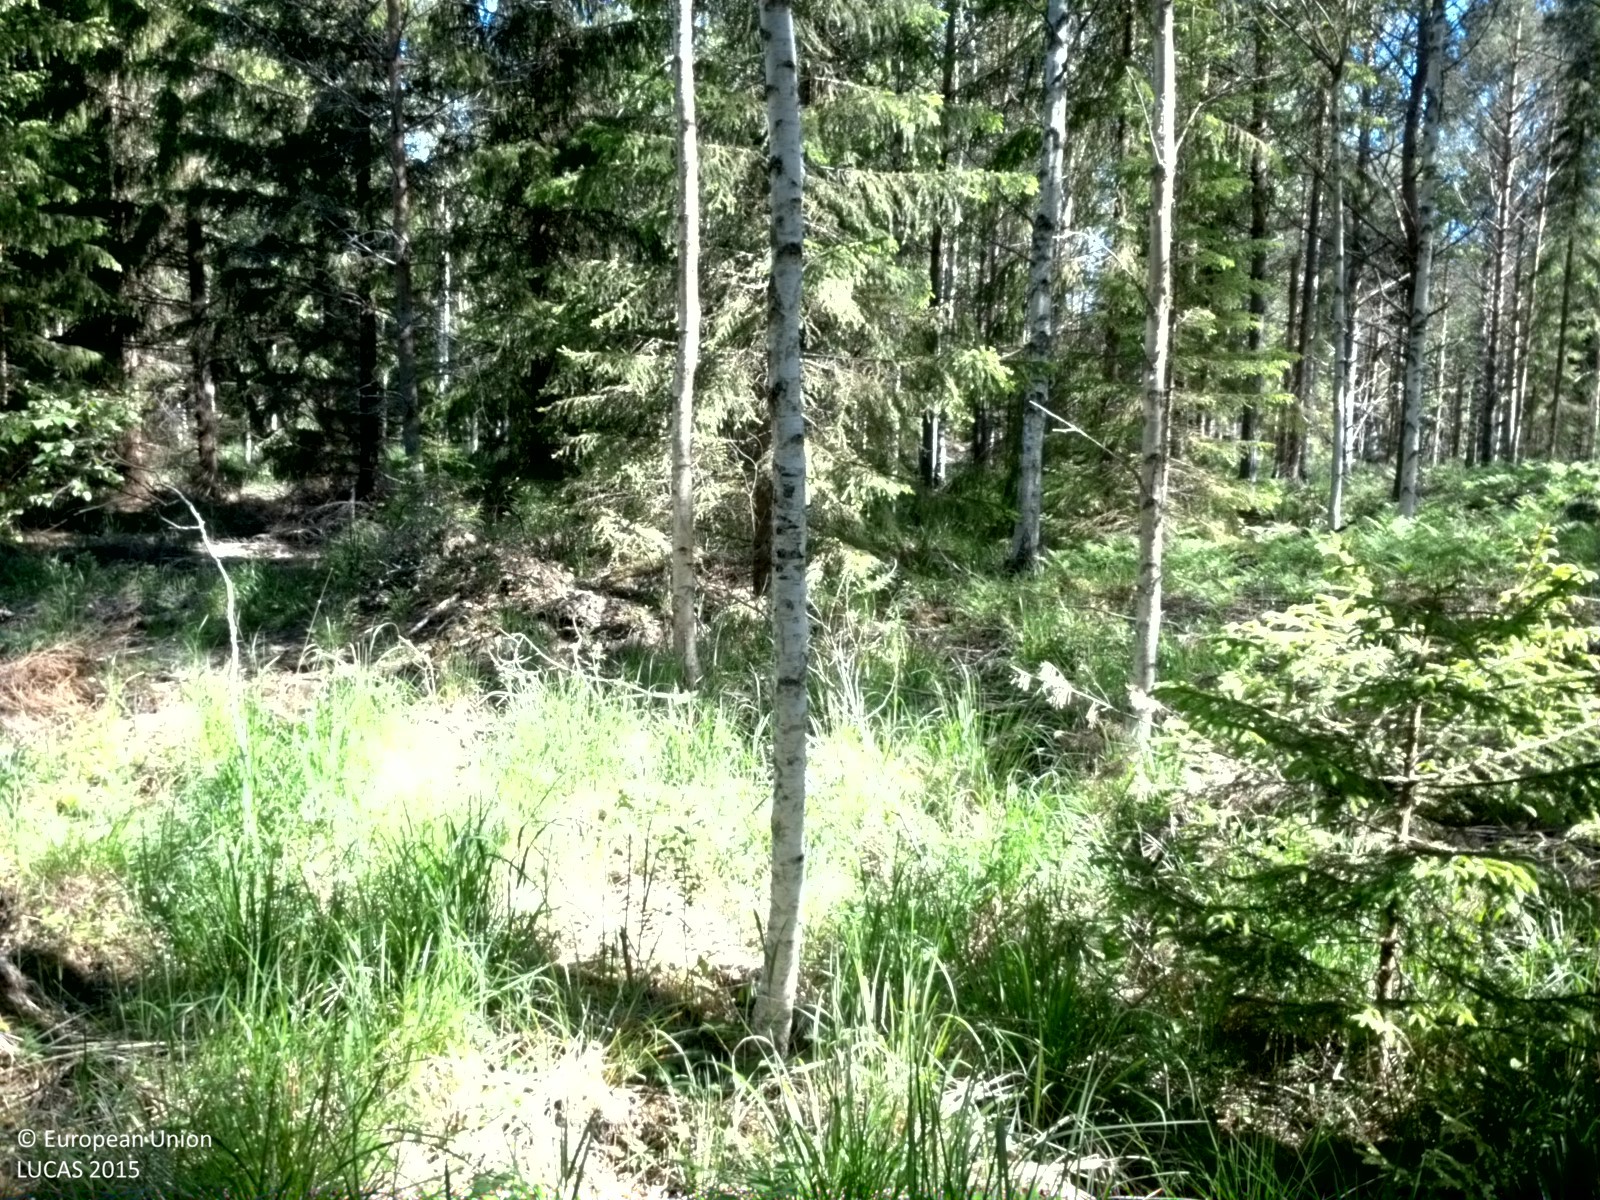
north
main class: Woodland
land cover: Pine dominated mixed woodland
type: boreal forest
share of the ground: 50 - 75 %
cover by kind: coniferous forest trees 45 %, broadleaved forest trees 20 %, herbaceous plants 20 %, shrubs 10 %
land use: Forestry
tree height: > 5 m
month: June
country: SE
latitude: 60.2312
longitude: 17.5579
